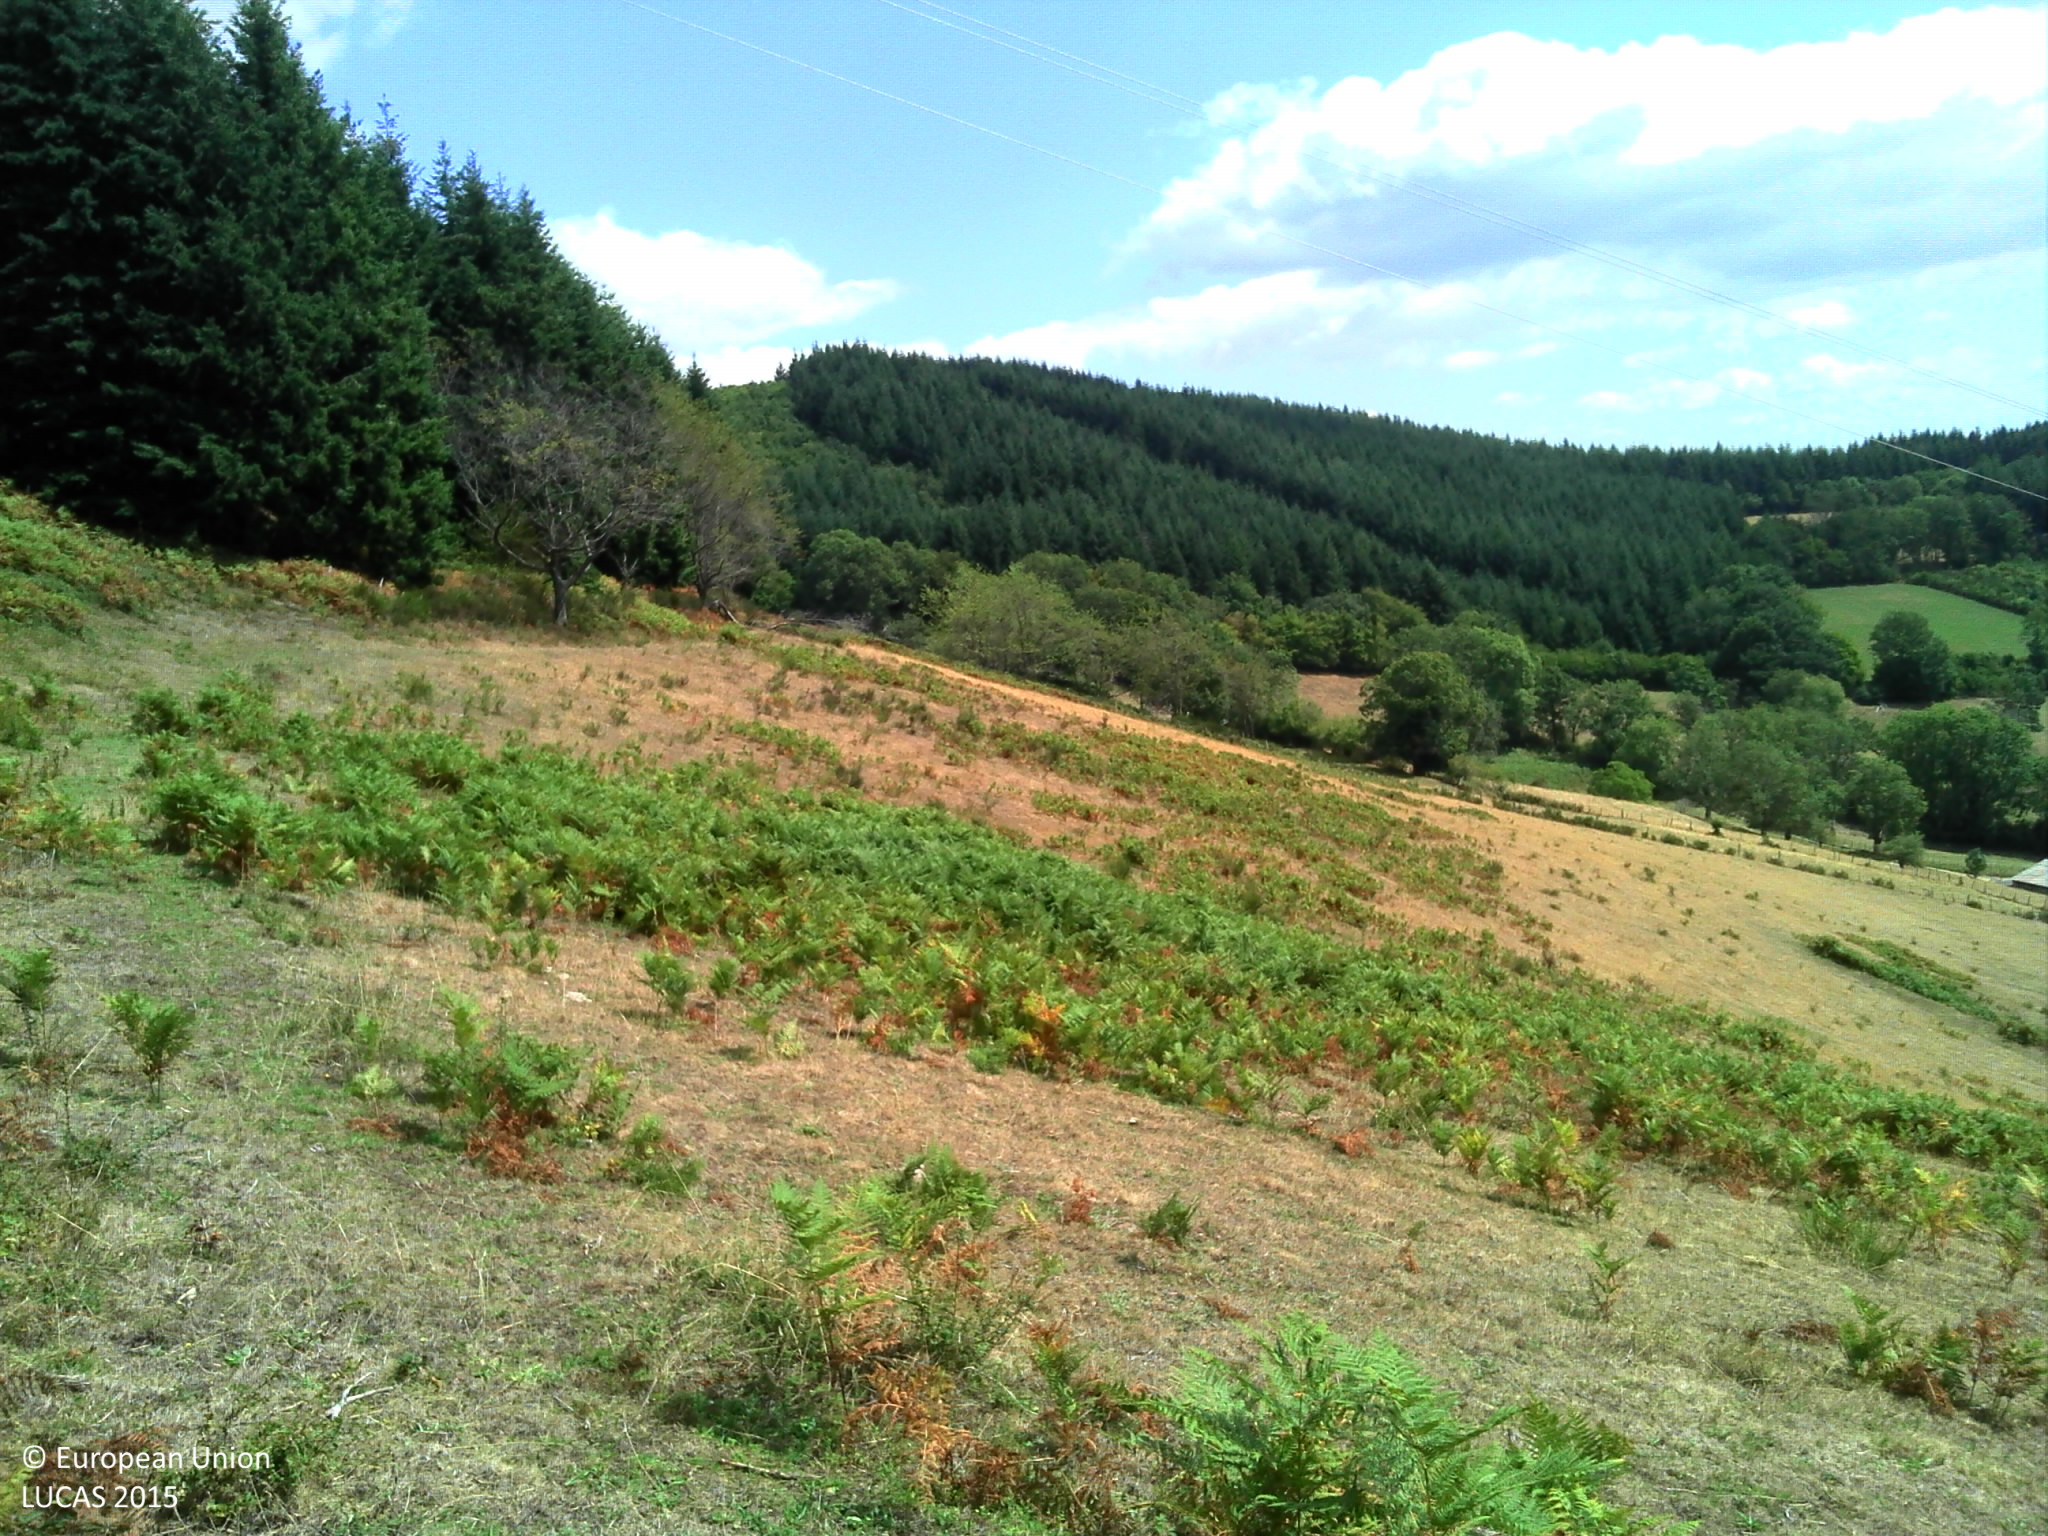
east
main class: Grassland
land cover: Spontaneously vegetated surfaces
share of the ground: > 75 %
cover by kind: herbaceous plants 100 %
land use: Agriculture (excluding fallow land and kitchen gardens)
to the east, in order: Spontaneously vegetated surfaces; Grassland without tree/shrub cover; Electric lines; Grassland without tree/shrub cover; Fences; Grassland without tree/shrub cover
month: August
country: FR
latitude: 46.1030
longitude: 4.5302
